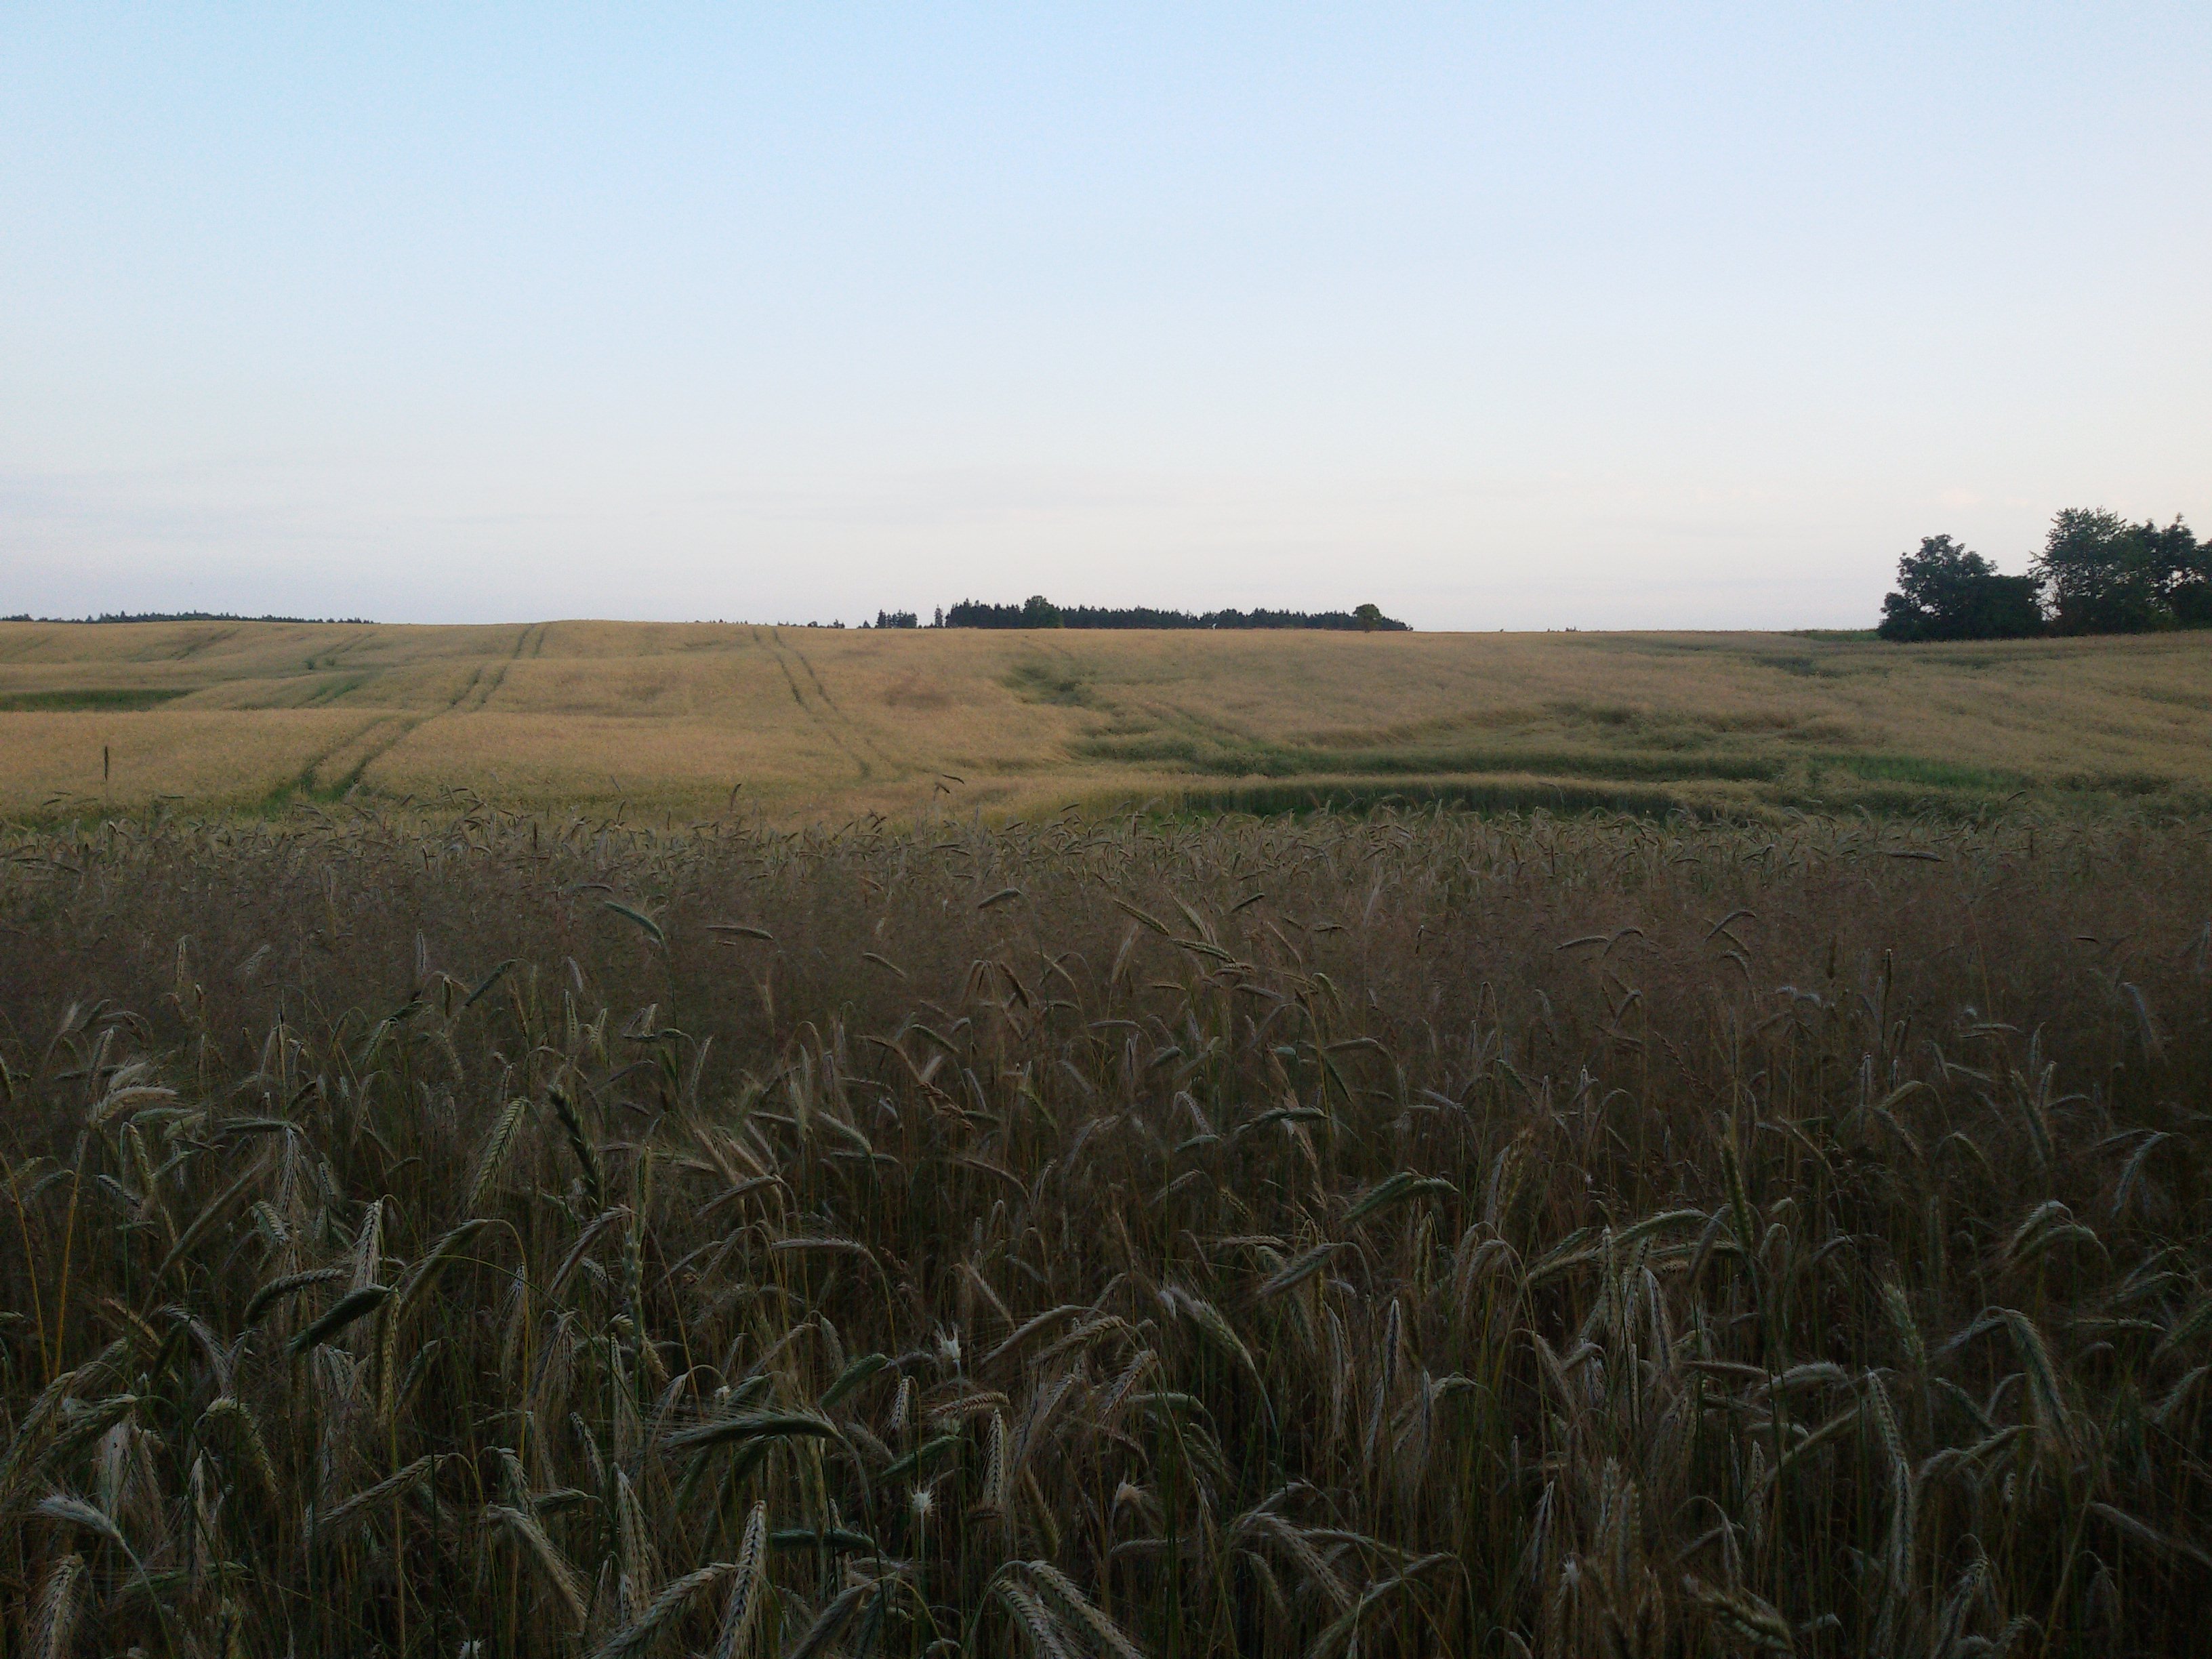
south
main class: Cropland
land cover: Rye
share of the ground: > 75 %
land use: Agriculture (excluding fallow land and kitchen gardens)
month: July
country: PL
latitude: 53.8371
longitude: 15.8547
